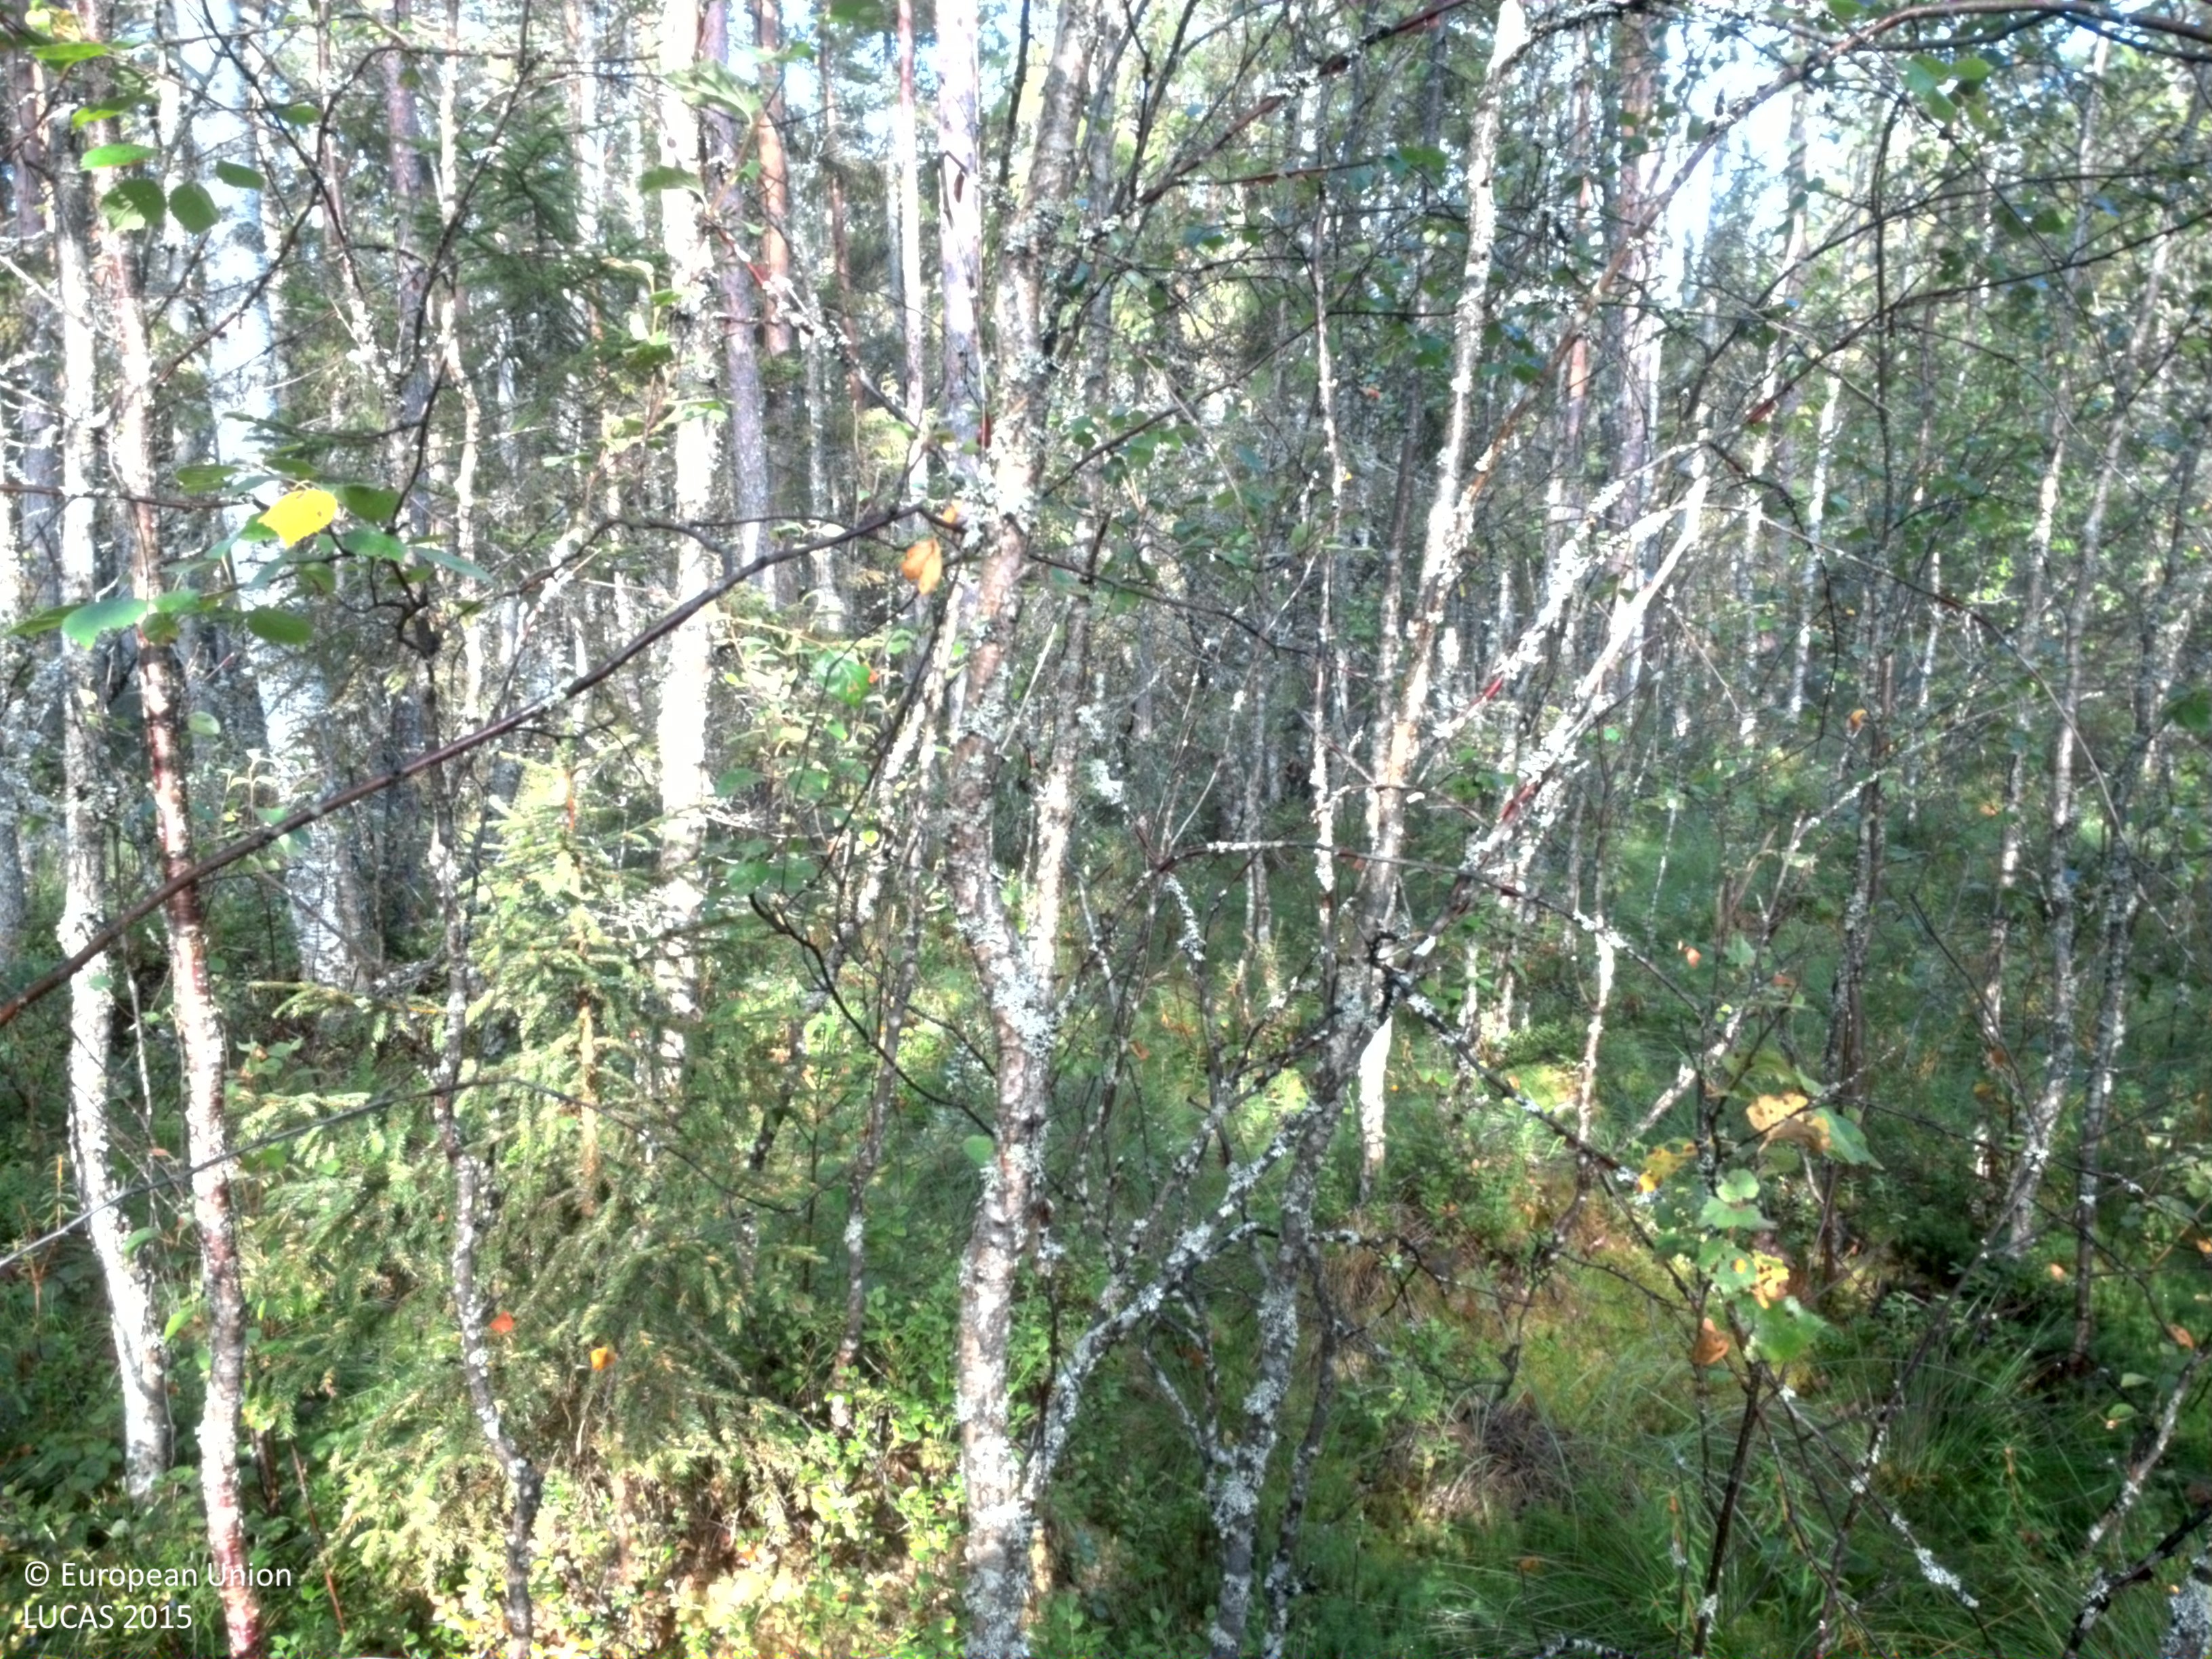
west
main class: Woodland
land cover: Pine dominated mixed woodland
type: boreal forest
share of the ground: 50 - 75 %
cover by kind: coniferous forest trees 45 %, broadleaved forest trees 20 %, shrubs 20 %, lichens and mosses 15 %
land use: Forestry
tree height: > 5 m
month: August
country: SE
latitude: 59.8165
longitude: 15.6071
